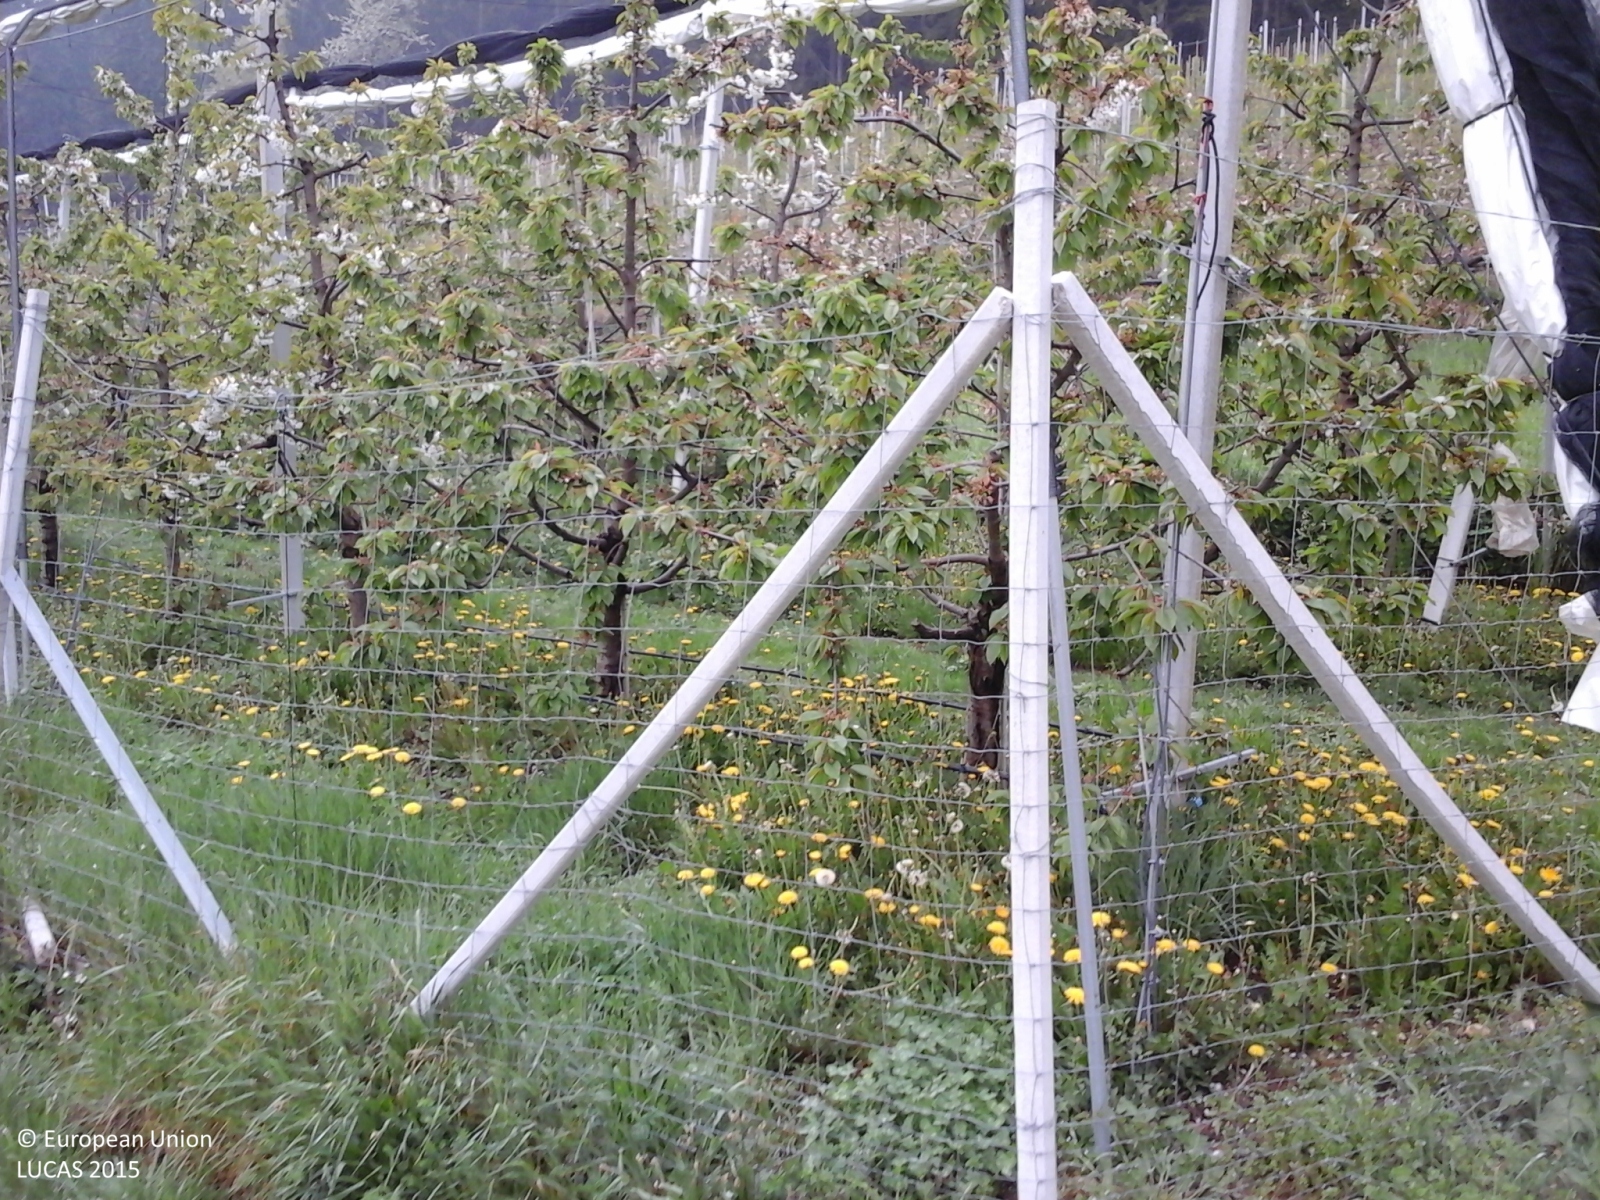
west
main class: Cropland
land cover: Apple fruit
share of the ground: 50 - 75 %
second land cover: Grassland without tree/shrub cover
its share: 25 - 50 %
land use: Agriculture (excluding fallow land and kitchen gardens)
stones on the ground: < 10 %
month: May
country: IT
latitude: 46.4536
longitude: 11.1052
